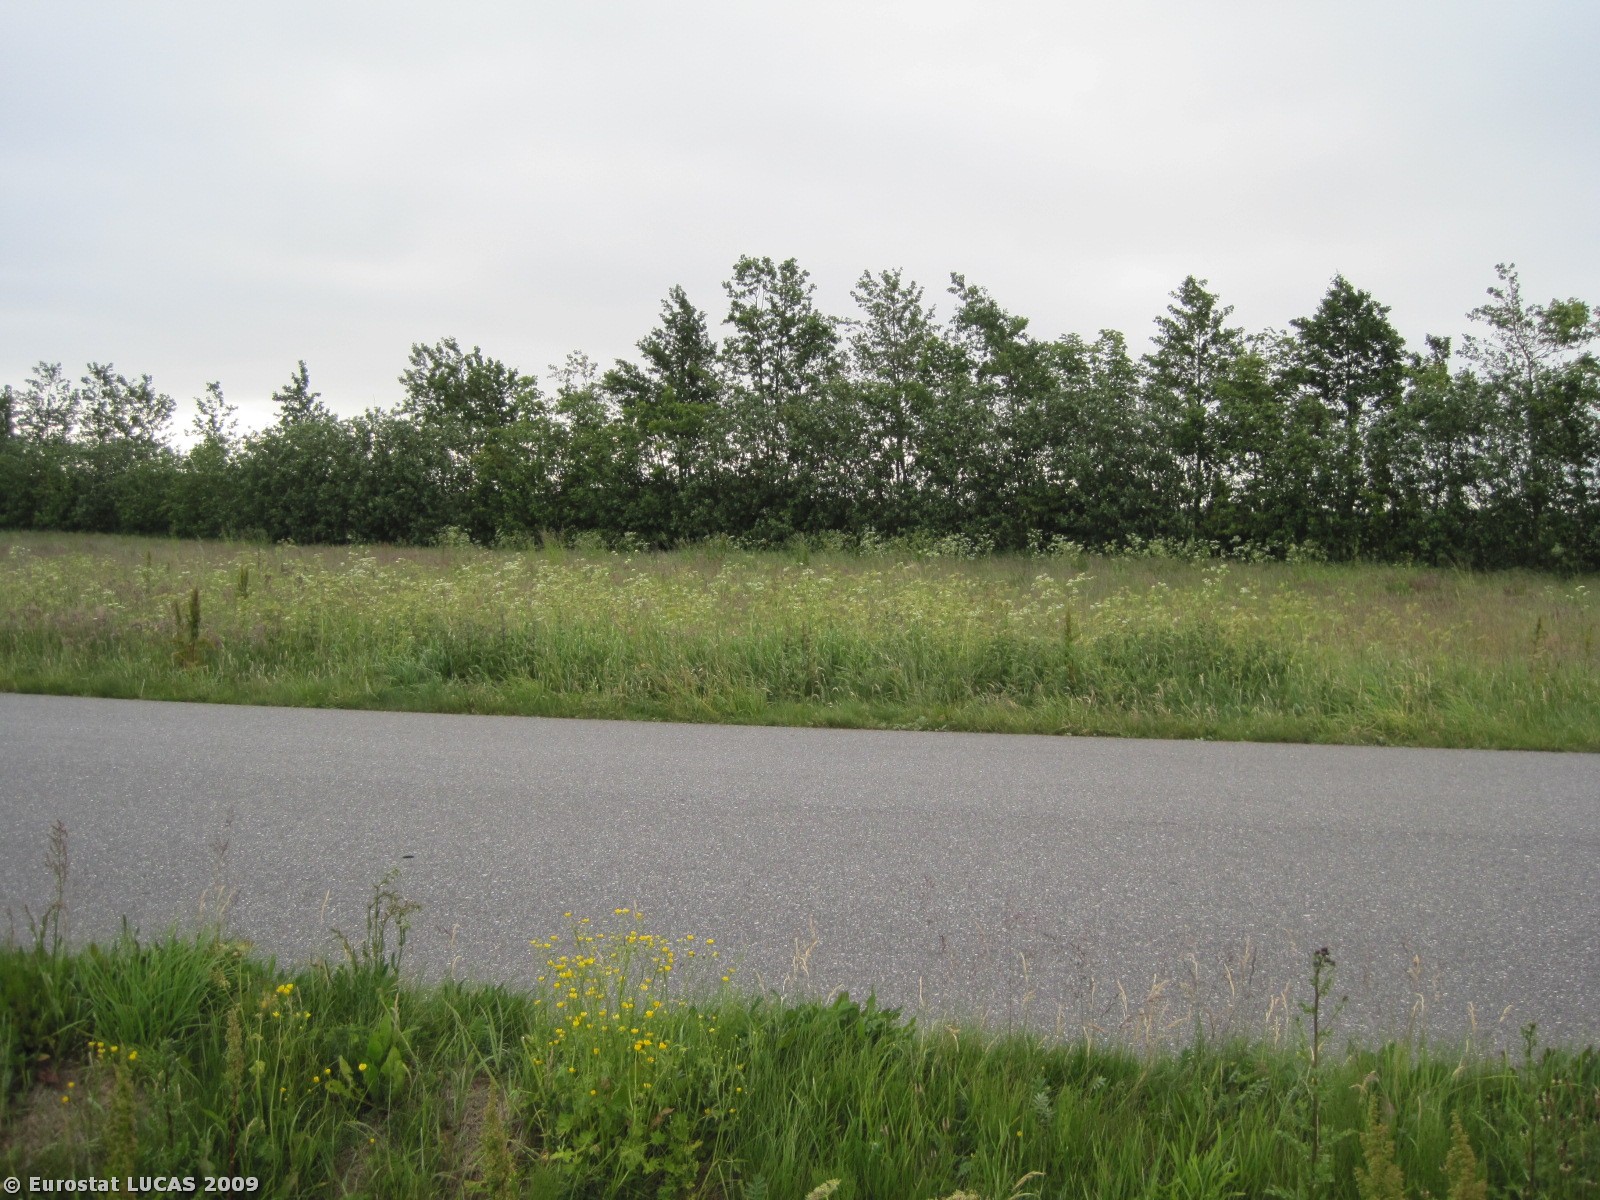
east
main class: Cropland
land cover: Rye
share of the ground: 50 - 75 %
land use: Agriculture (excluding fallow land and kitchen gardens)
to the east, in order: Rye; Grass margins; Ditches and canals; Grass margins; Paved roads, cycling and walking lanes; Grassland without tree/shrub cover; Abandoned hedges; Grass margins; Common wheat
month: June
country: DK
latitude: 57.1585
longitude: 10.0495
